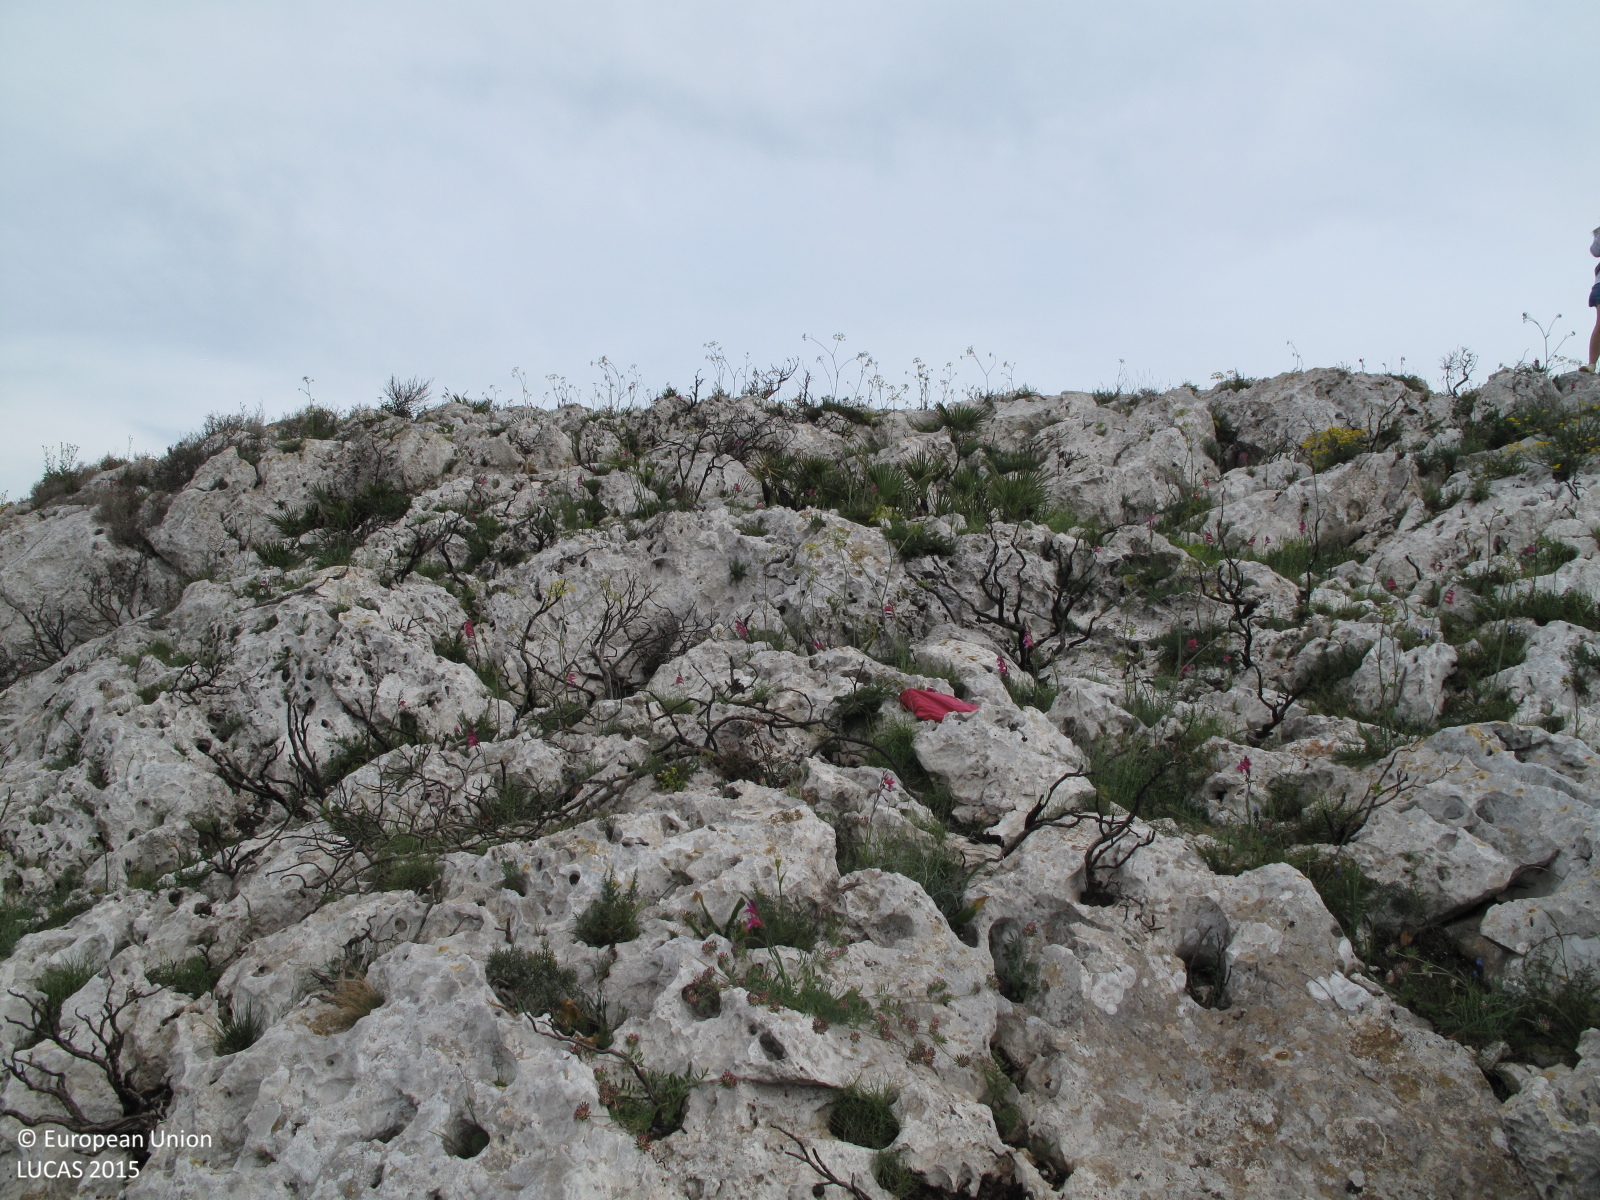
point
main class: Grassland
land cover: Grassland with sparse tree/shrub cover
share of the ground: 10 - 25 %
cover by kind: consolidated bare surface 80 %, herbaceous plants 10 %, broadleaved forest trees 5 %, shrubs 5 %
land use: Semi-natural and natural areas not in use
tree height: < 5 m
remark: Burnt area
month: April
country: ES
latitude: 38.8084
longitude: 0.1888
